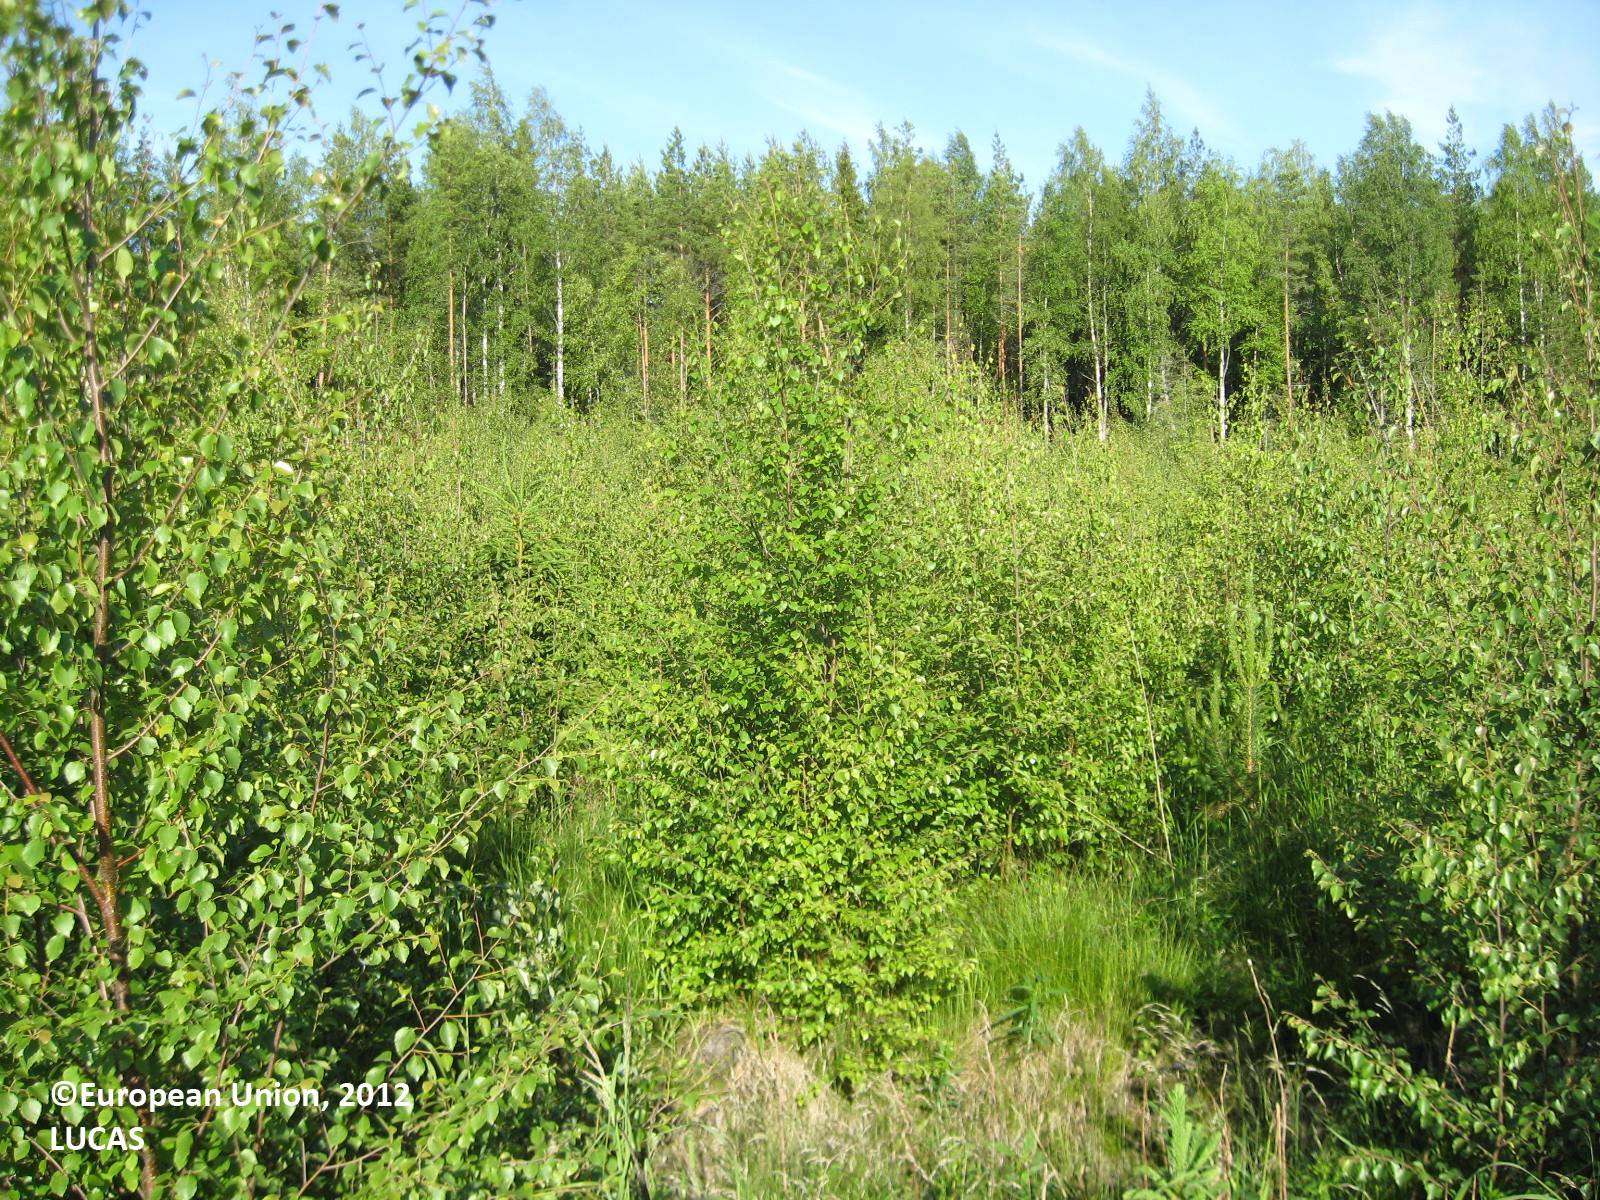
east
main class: Woodland
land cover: Broadleaved woodland
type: boreal forest
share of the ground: > 75 %
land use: Forestry
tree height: < 5 m
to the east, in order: Broadleaved woodland; Ditches and canals; Broadleaved woodland; Ditches and canals; Broadleaved woodland; Ditches and canals; Broadleaved woodland; Ditches and canals; Broadleaved woodland; Pine dominated mixed woodland; Pine dominated coniferous woodland
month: June
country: FI
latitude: 62.6189
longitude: 21.6012
